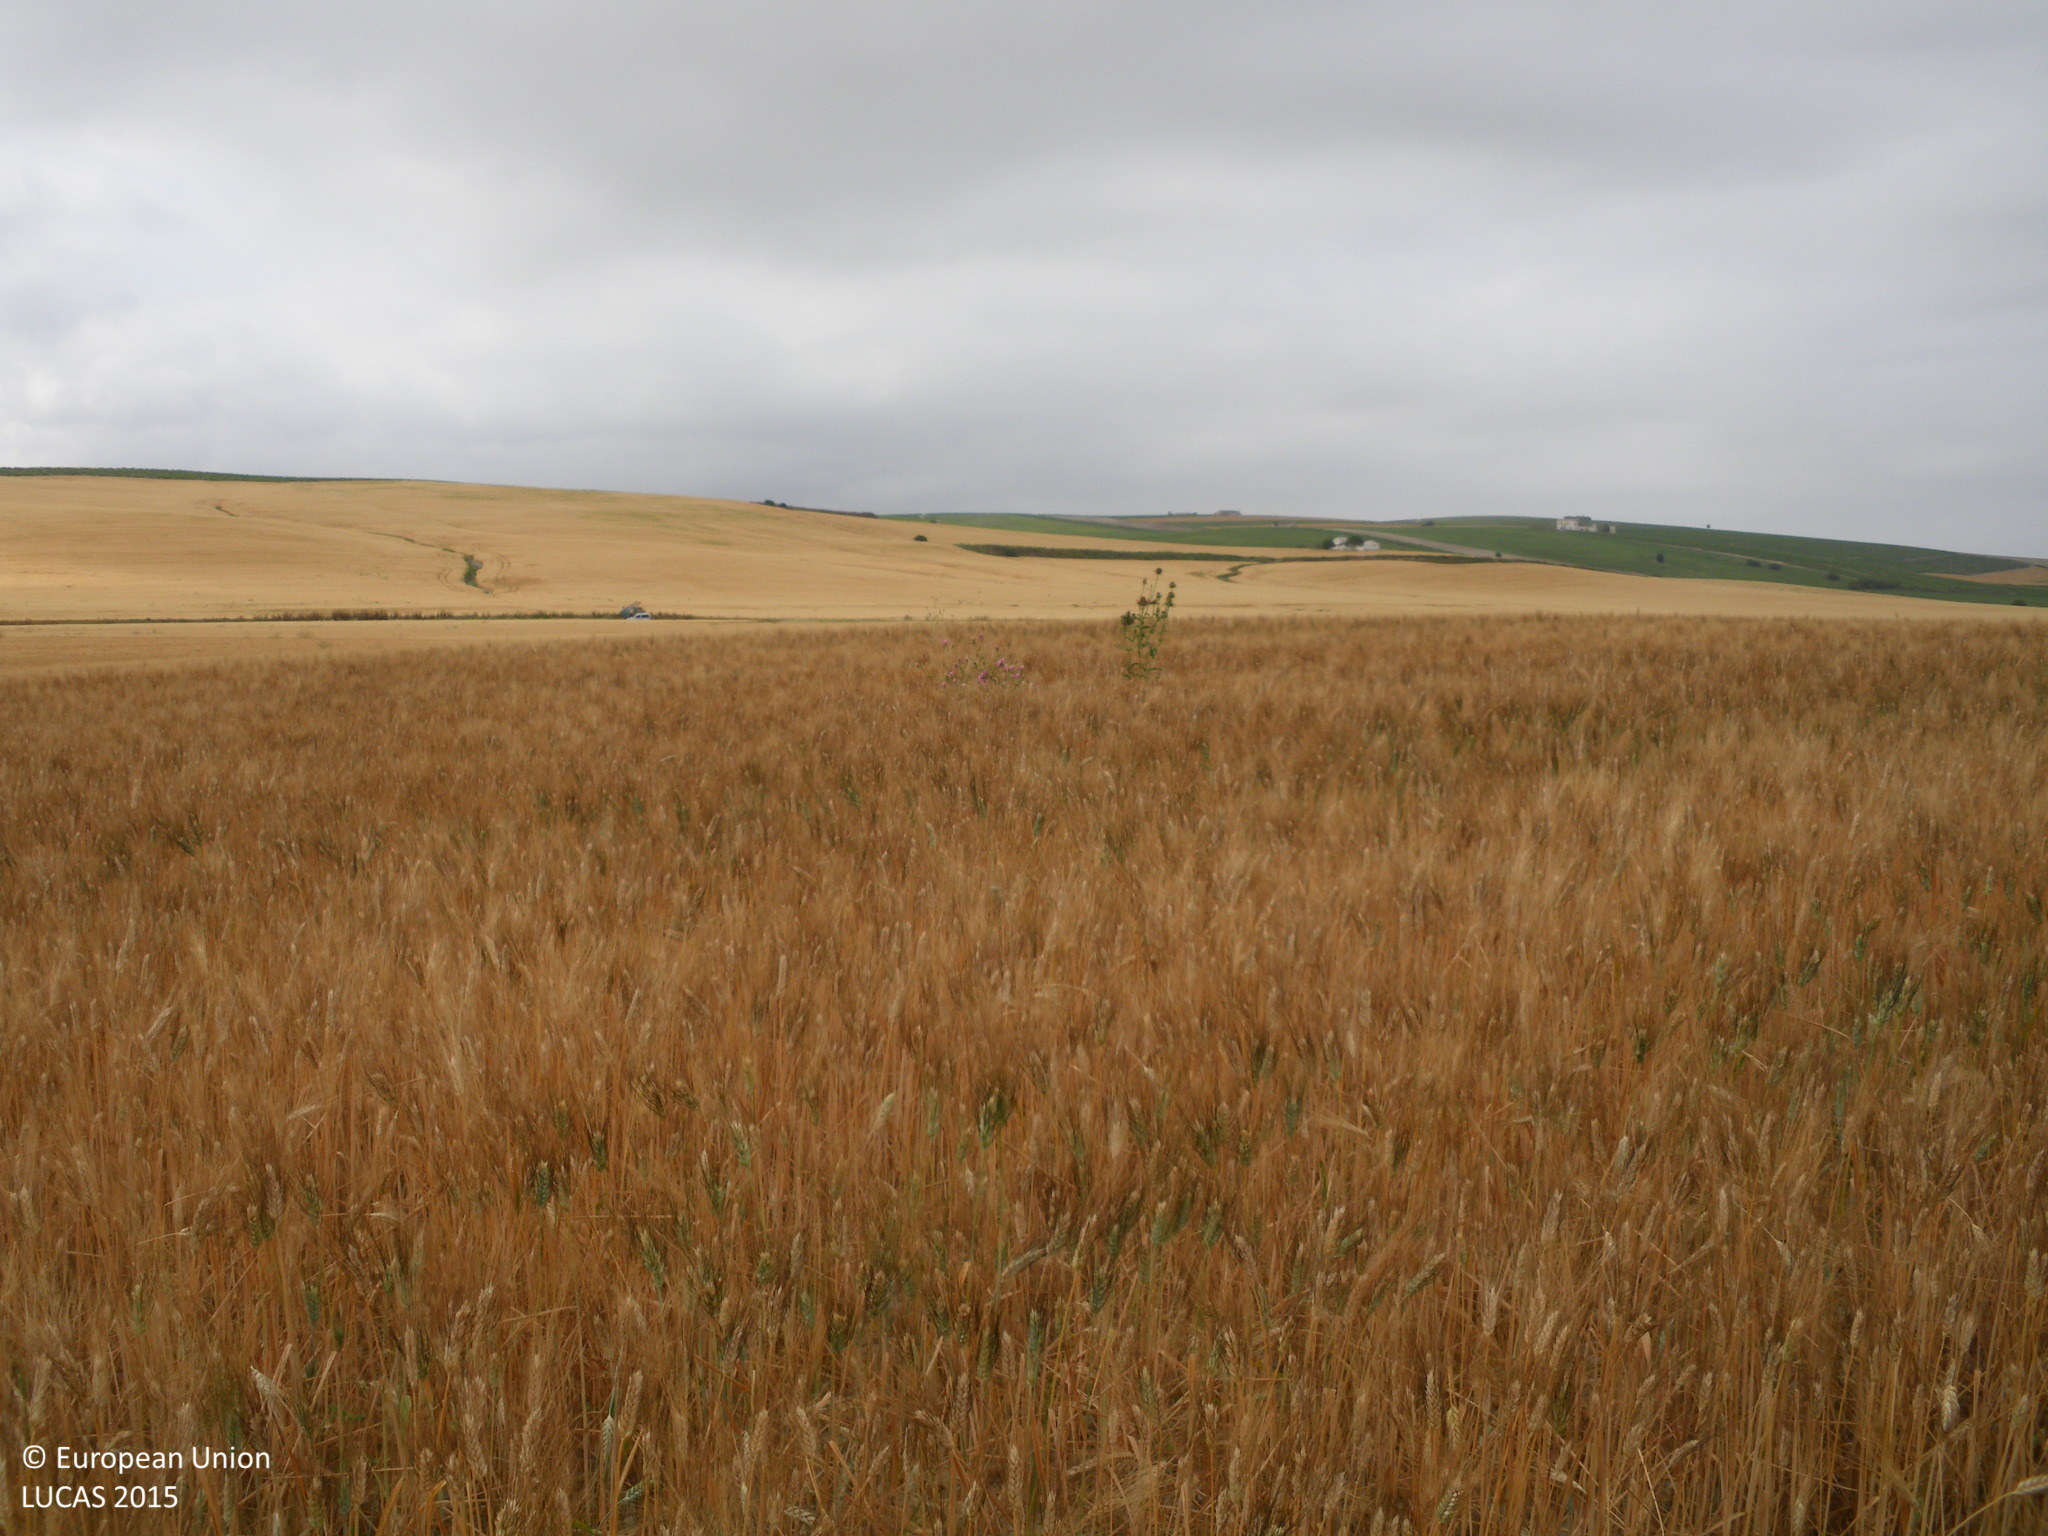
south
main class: Cropland
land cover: Durum wheat
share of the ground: > 75 %
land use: Agriculture (excluding fallow land and kitchen gardens)
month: May
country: ES
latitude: 36.7544
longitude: -6.2002
